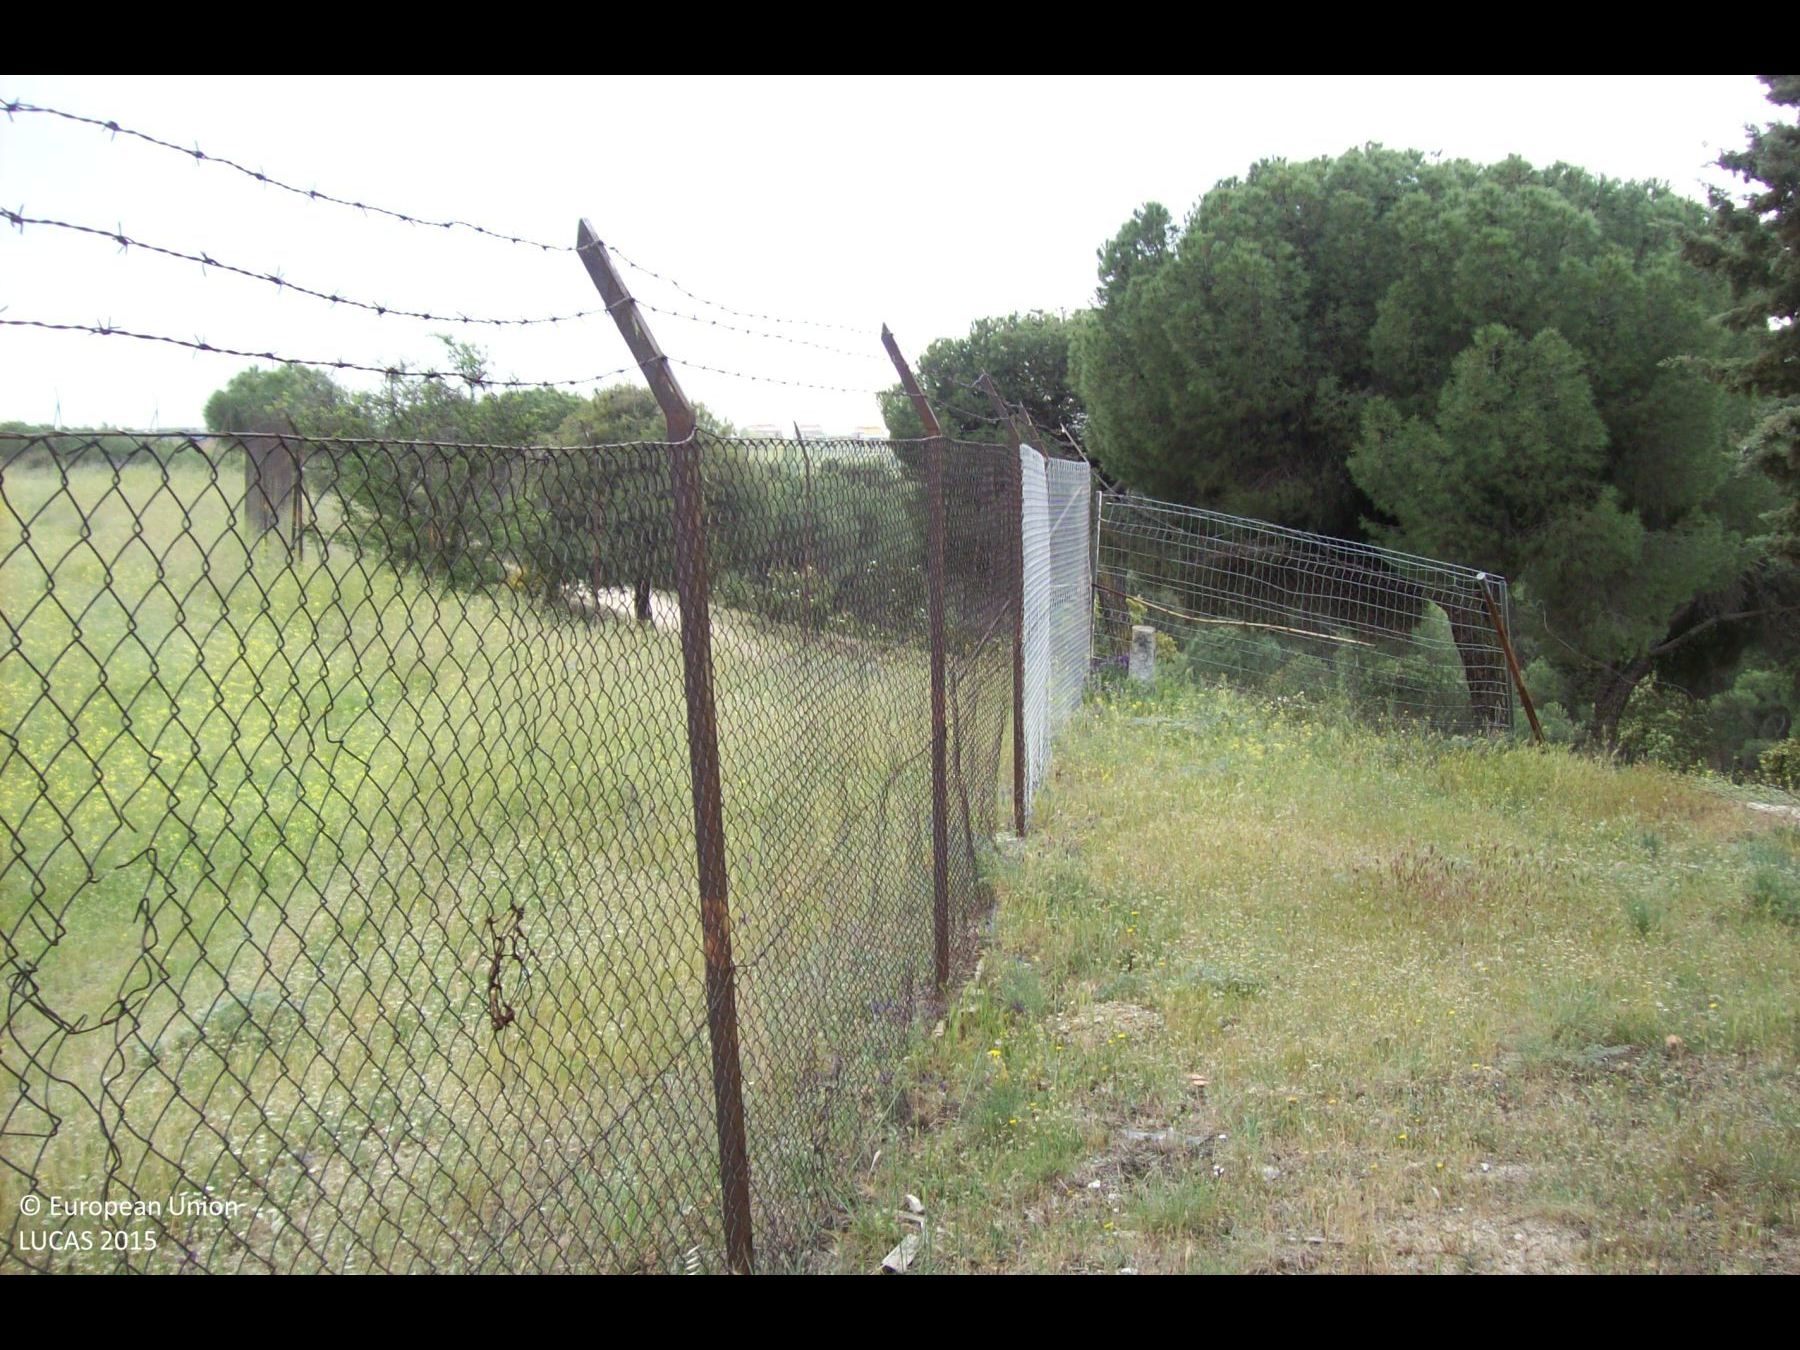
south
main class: Grassland
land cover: Grassland with sparse tree/shrub cover
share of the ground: > 75 %
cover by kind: herbaceous plants 95 %, coniferous forest trees 5 %
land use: Amenities, museums, leisure
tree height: < 5 m
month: April
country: ES
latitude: 40.4850
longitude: -3.8789
